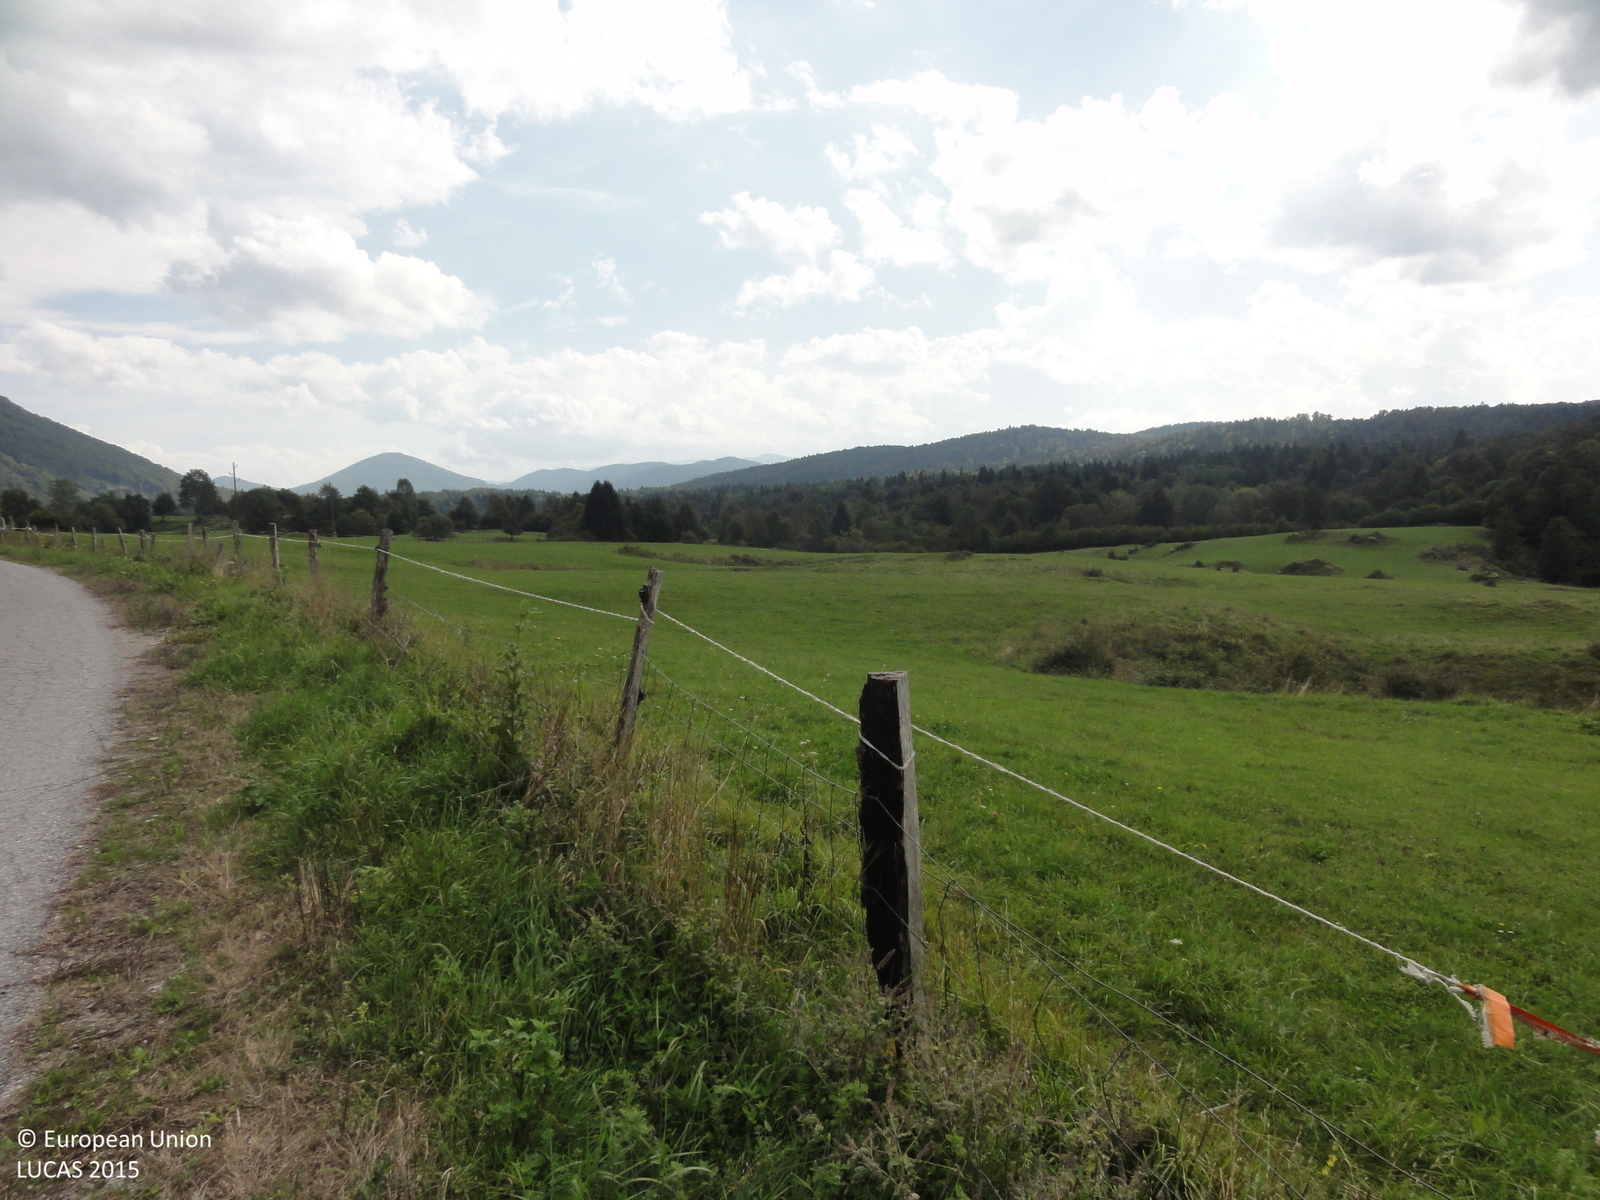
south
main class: Grassland
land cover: Grassland without tree/shrub cover
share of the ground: > 75 %
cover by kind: herbaceous plants 100 %
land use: Agriculture (excluding fallow land and kitchen gardens)
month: September
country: SI
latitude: 45.5303
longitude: 15.0023
